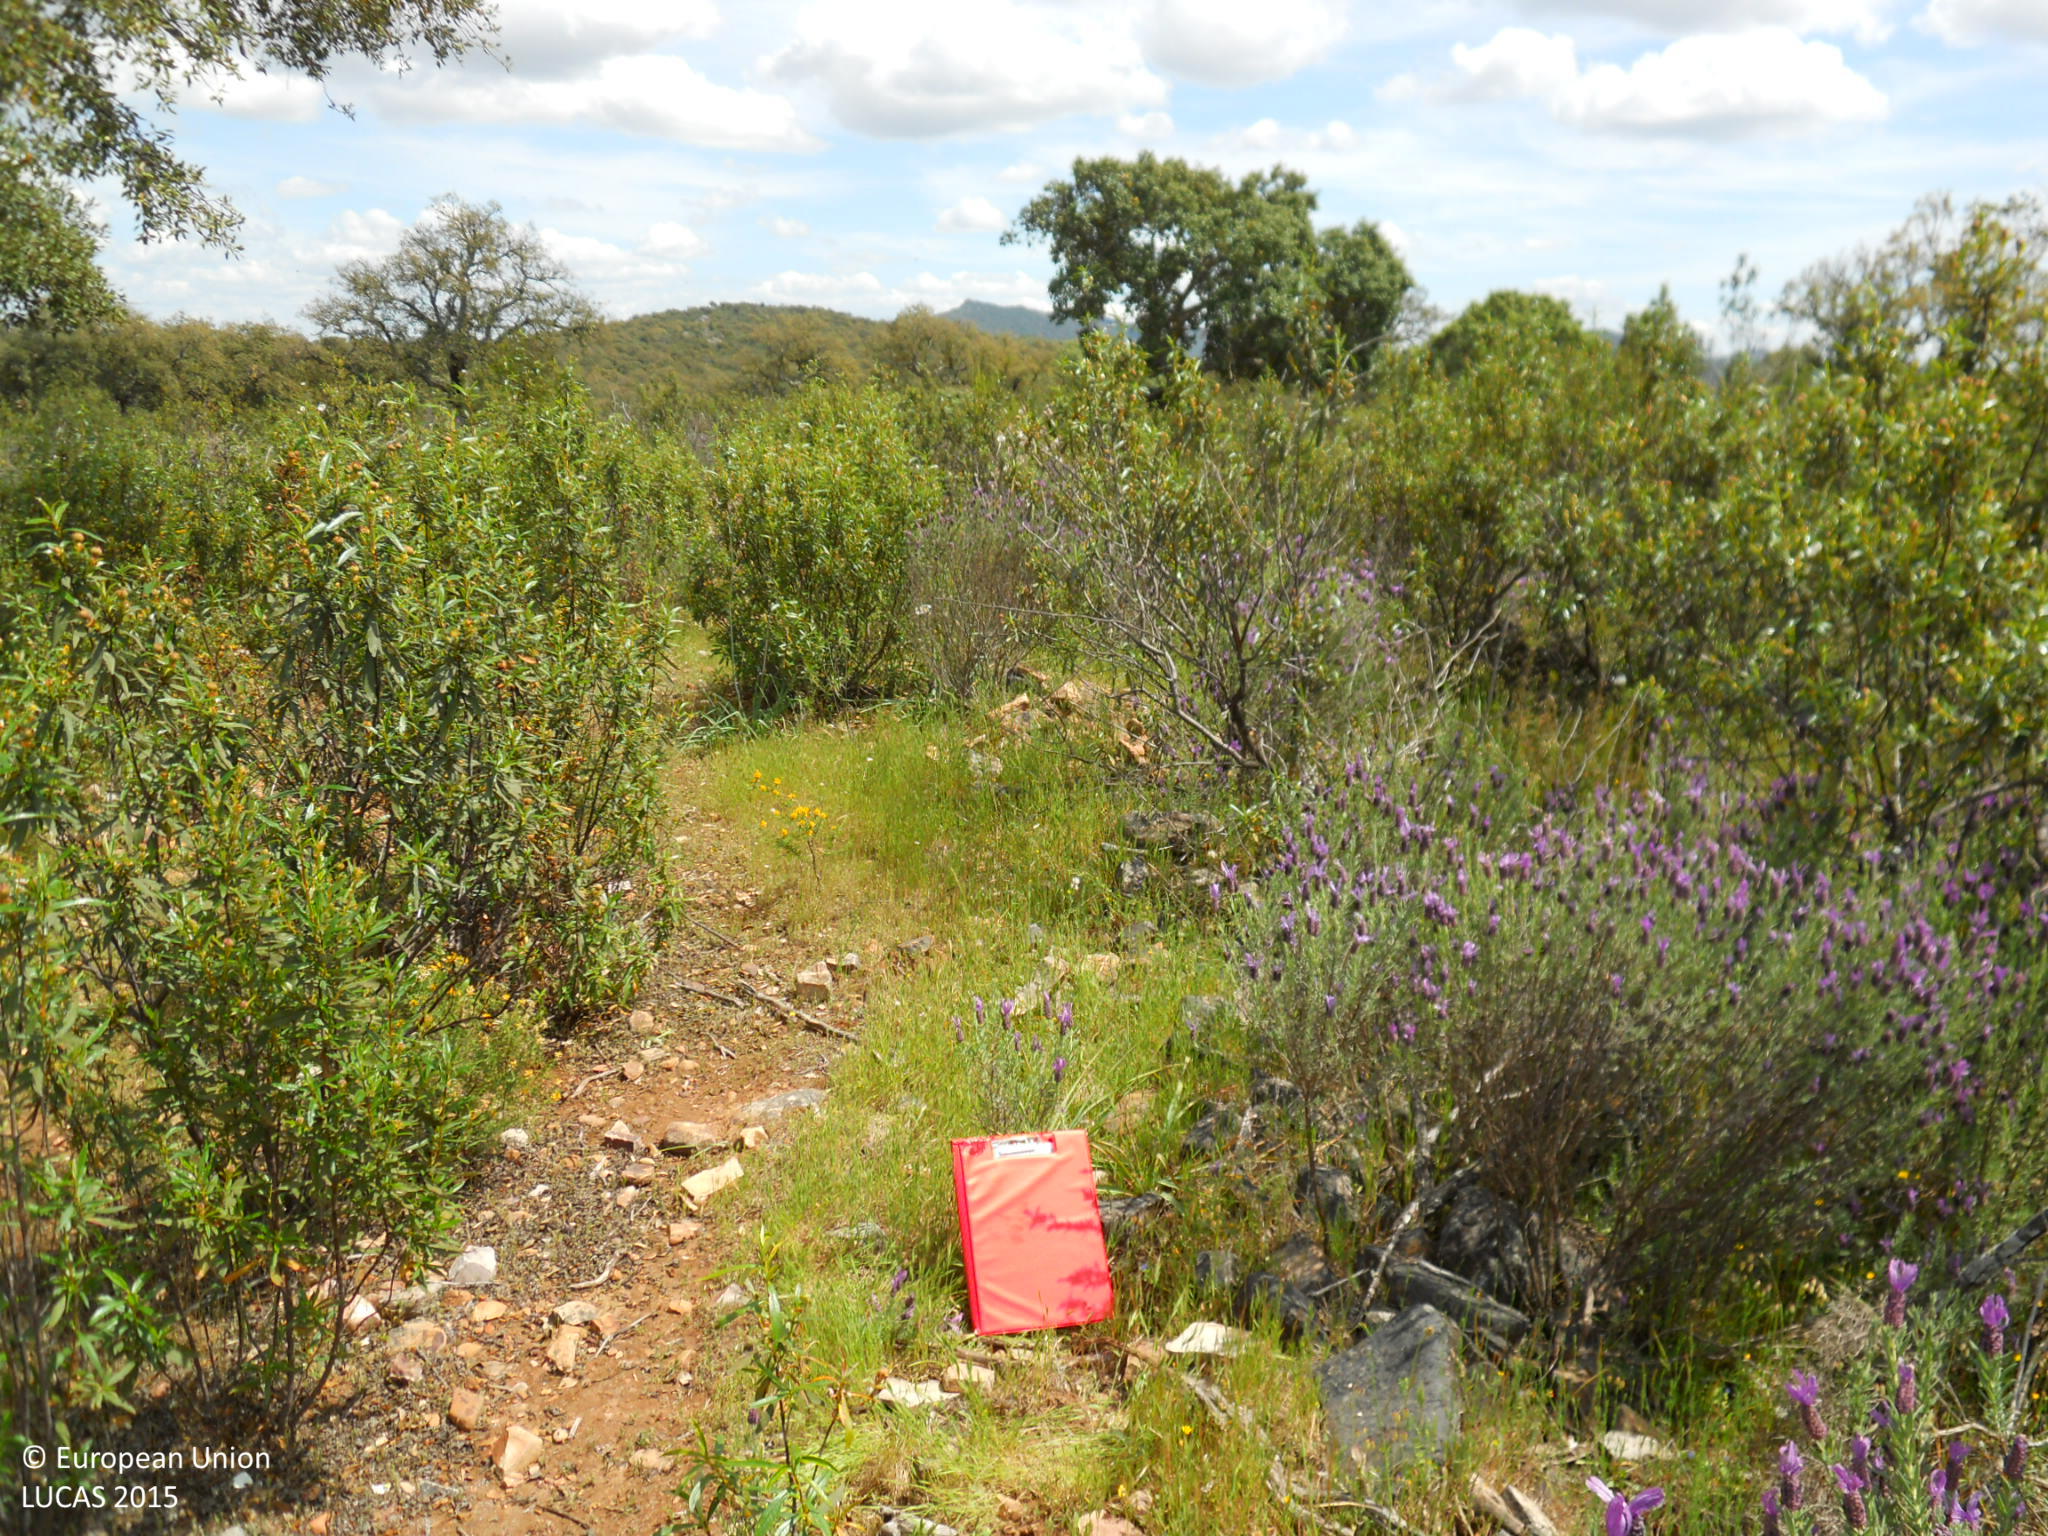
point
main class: Shrubland
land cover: Shrubland with sparse tree cover
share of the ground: > 75 %
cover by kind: shrubs 85 %, herbaceous plants 10 %, broadleaved forest trees 5 %
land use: Forestry
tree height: > 5 m
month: April
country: ES
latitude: 39.3115
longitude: -6.5491
